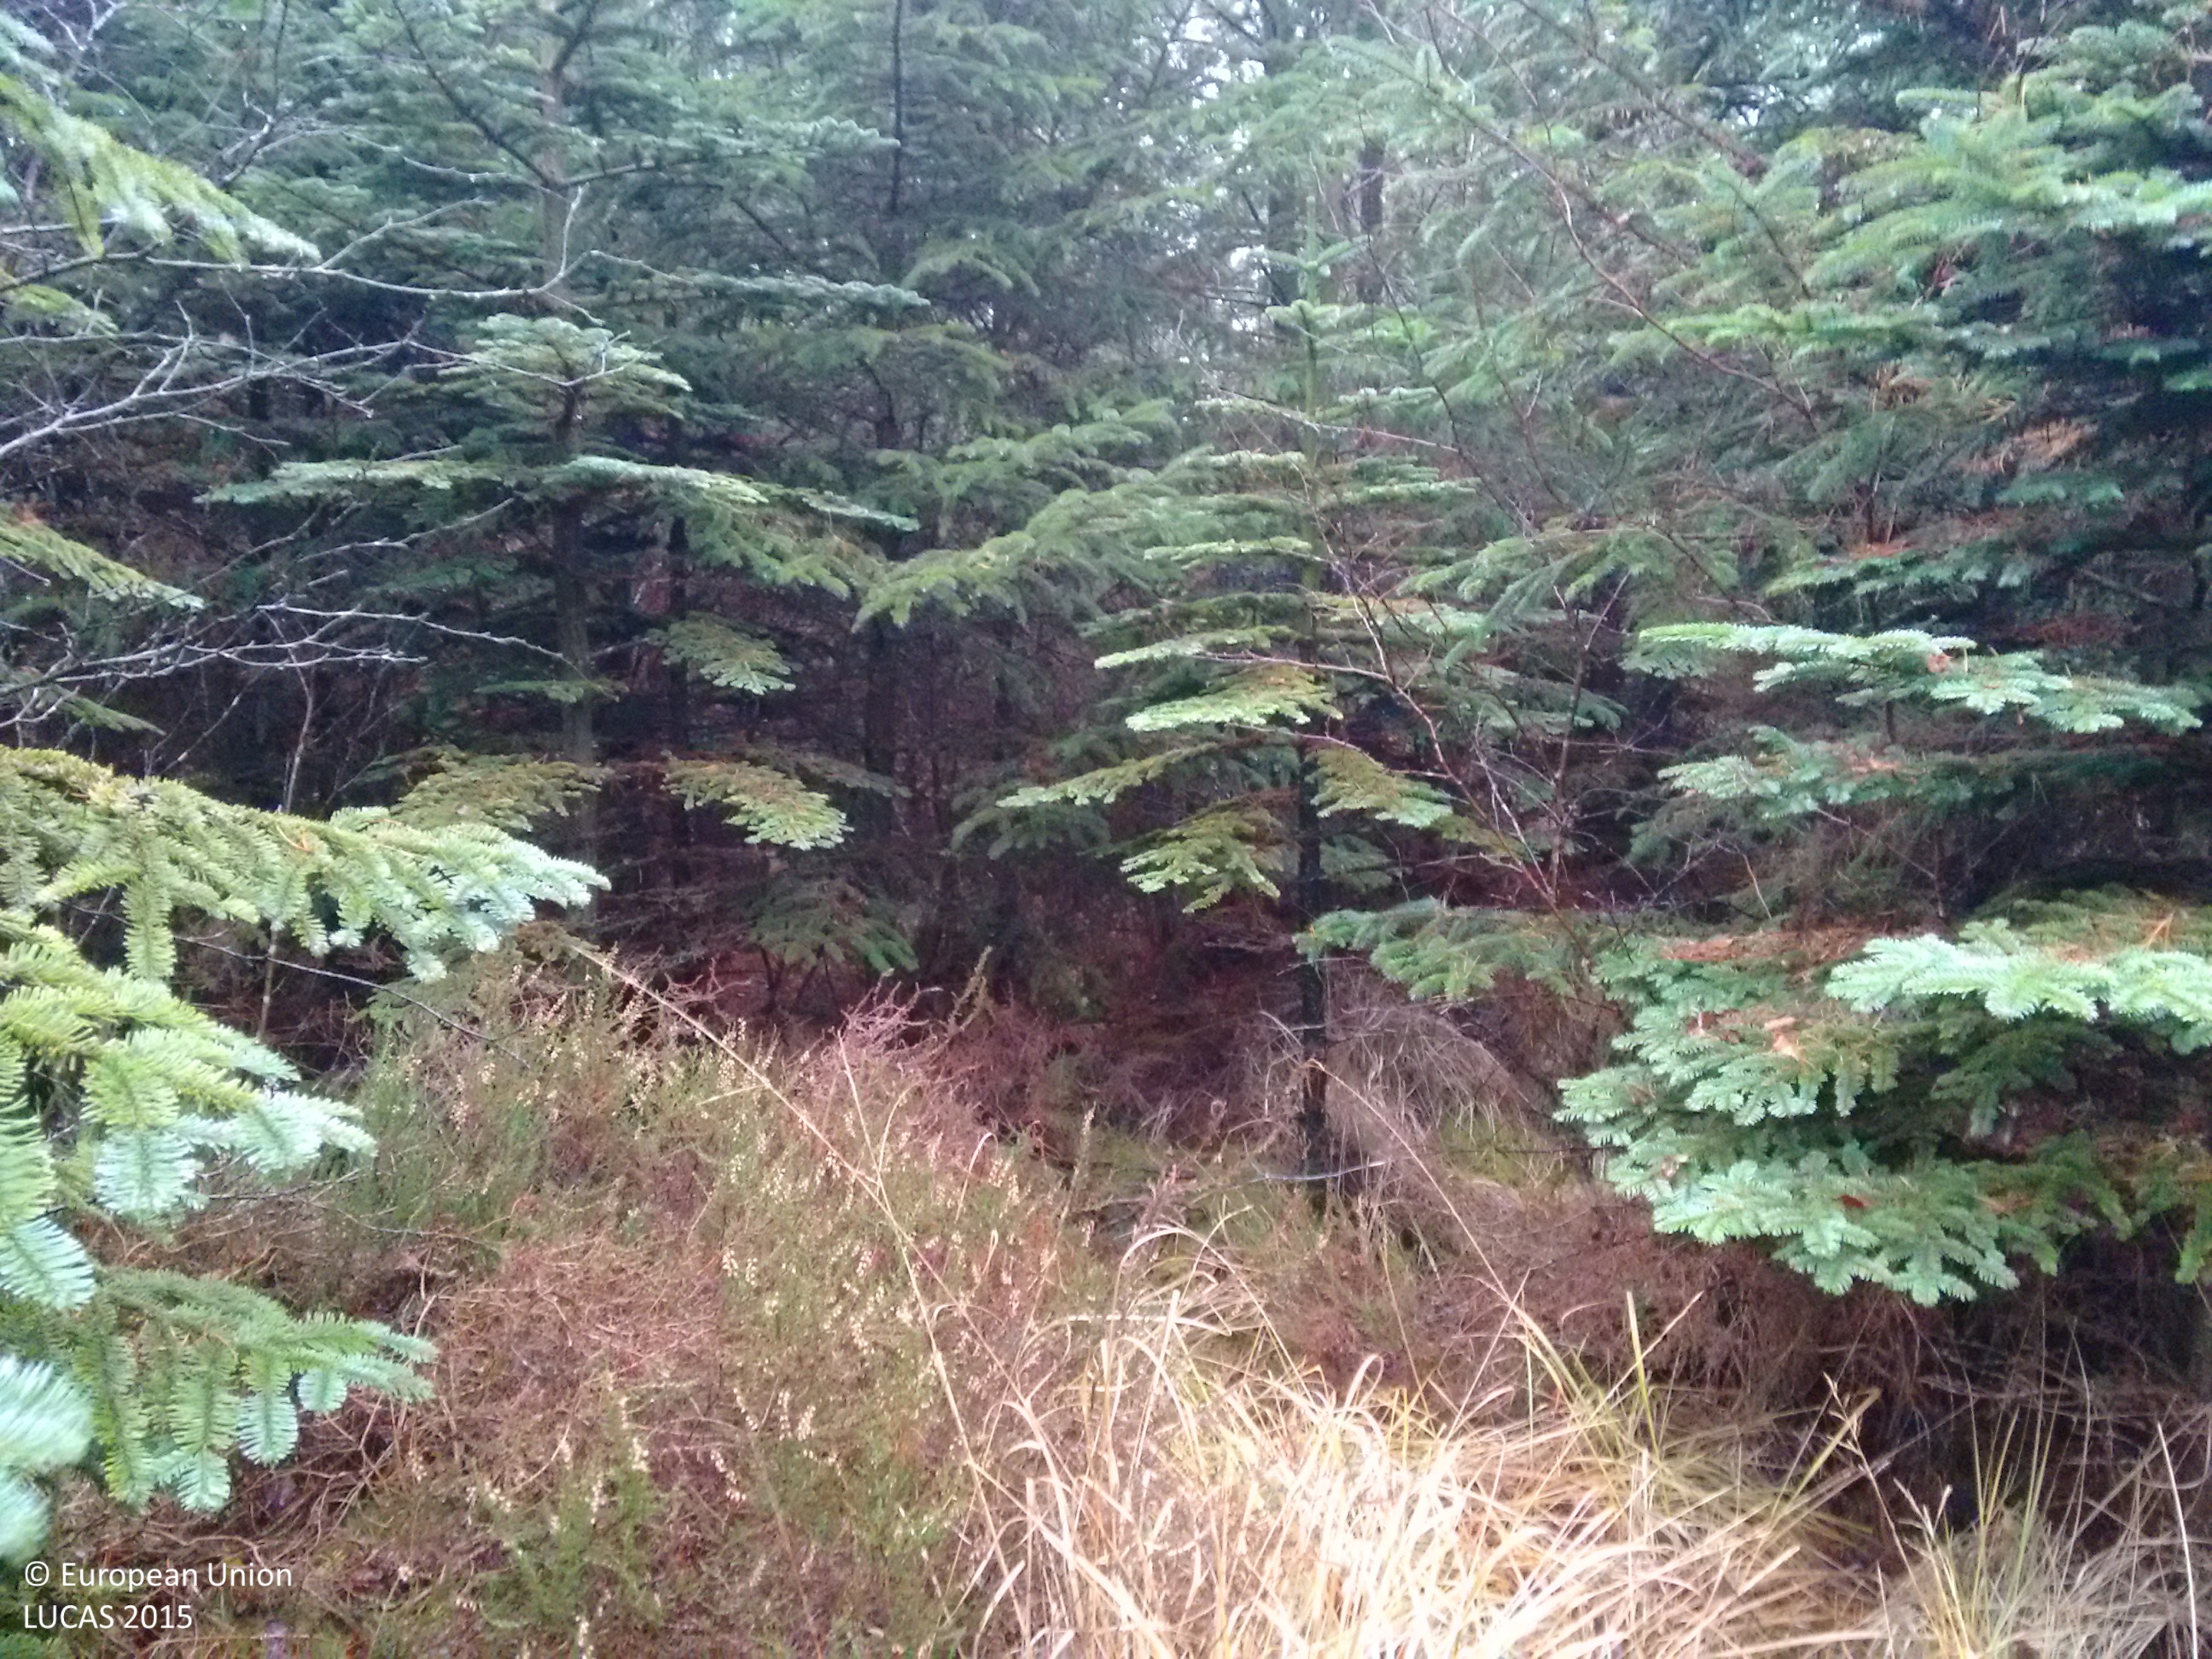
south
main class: Woodland
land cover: Pine dominated coniferous woodland
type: exotic forest
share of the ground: > 75 %
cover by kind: coniferous forest trees 100 %
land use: Forestry
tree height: > 5 m
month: November
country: GB
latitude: 52.9511
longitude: -4.2846
